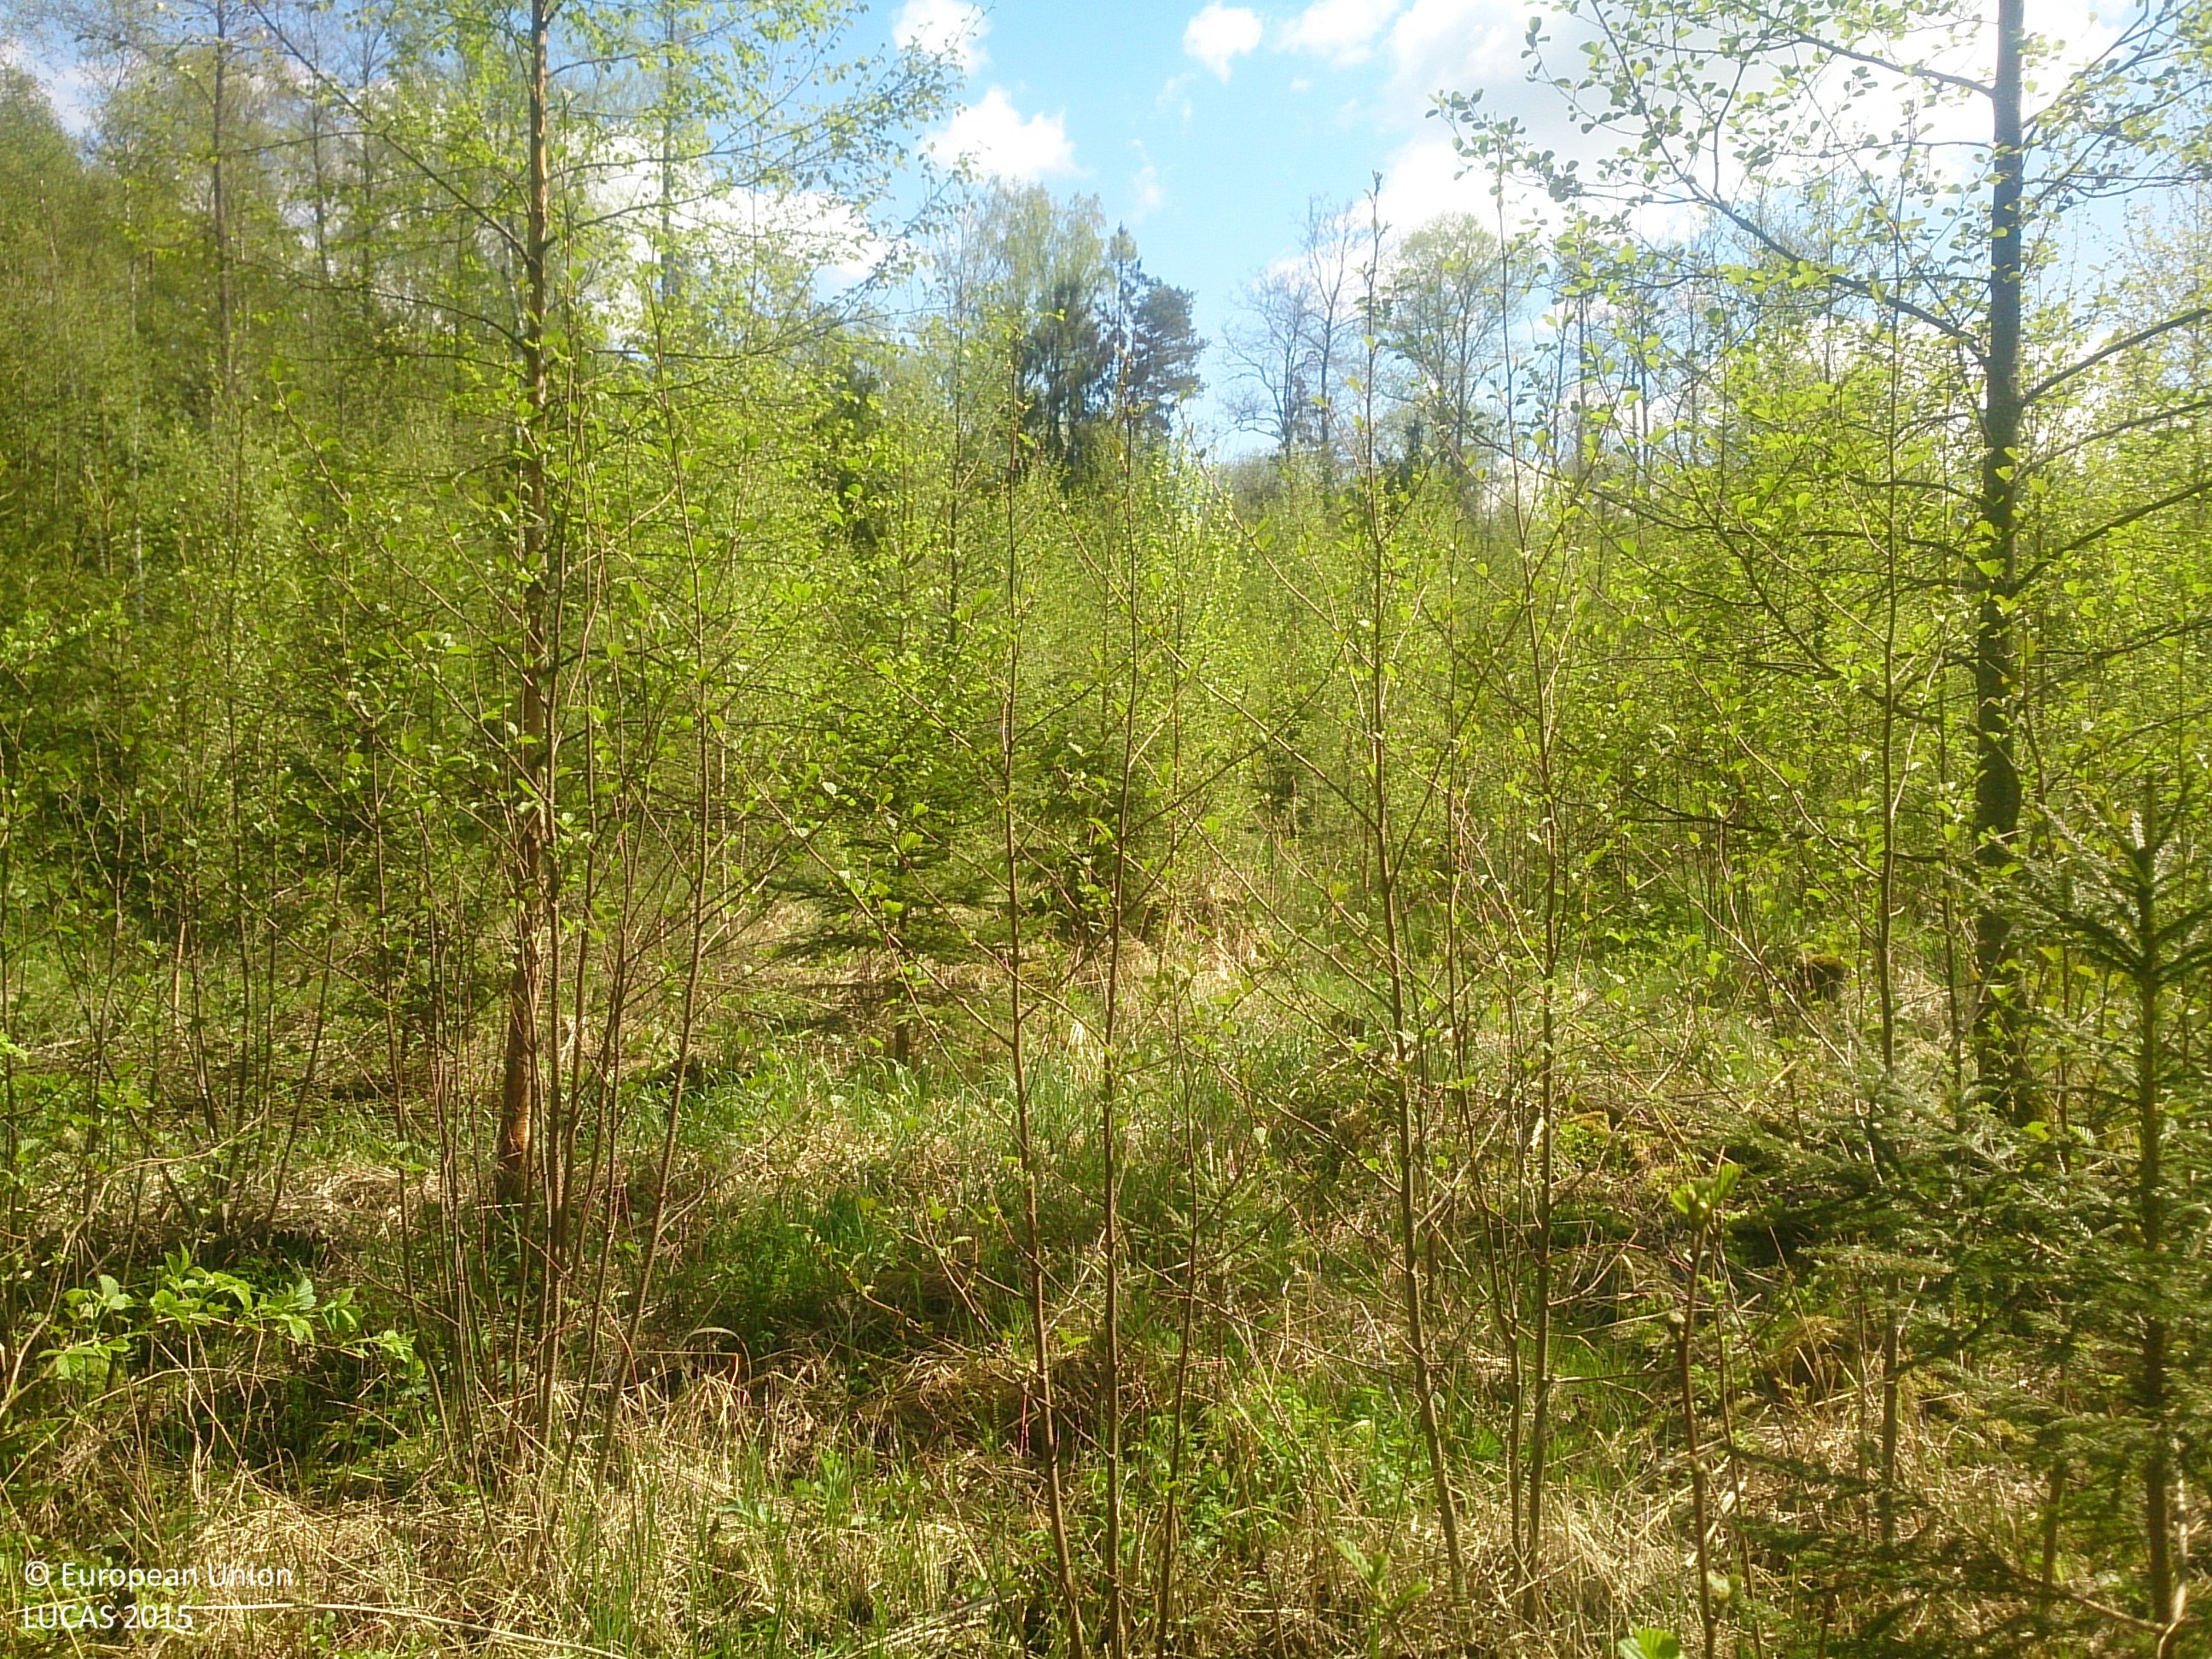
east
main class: Woodland
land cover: Spruce dominated mixed woodland
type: hemiboreal forest and nemoral coniferous forest and mixed broadleaved-coniferous forest
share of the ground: 25 - 50 %
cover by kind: herbaceous plants 50 %, broadleaved forest trees 25 %, coniferous forest trees 20 %, shrubs 5 %
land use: Forestry
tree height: < 5 m
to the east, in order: Spruce dominated mixed woodland; Other mixed woodland; Other coniferous woodland
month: May
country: LV
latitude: 56.7709
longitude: 24.1420
